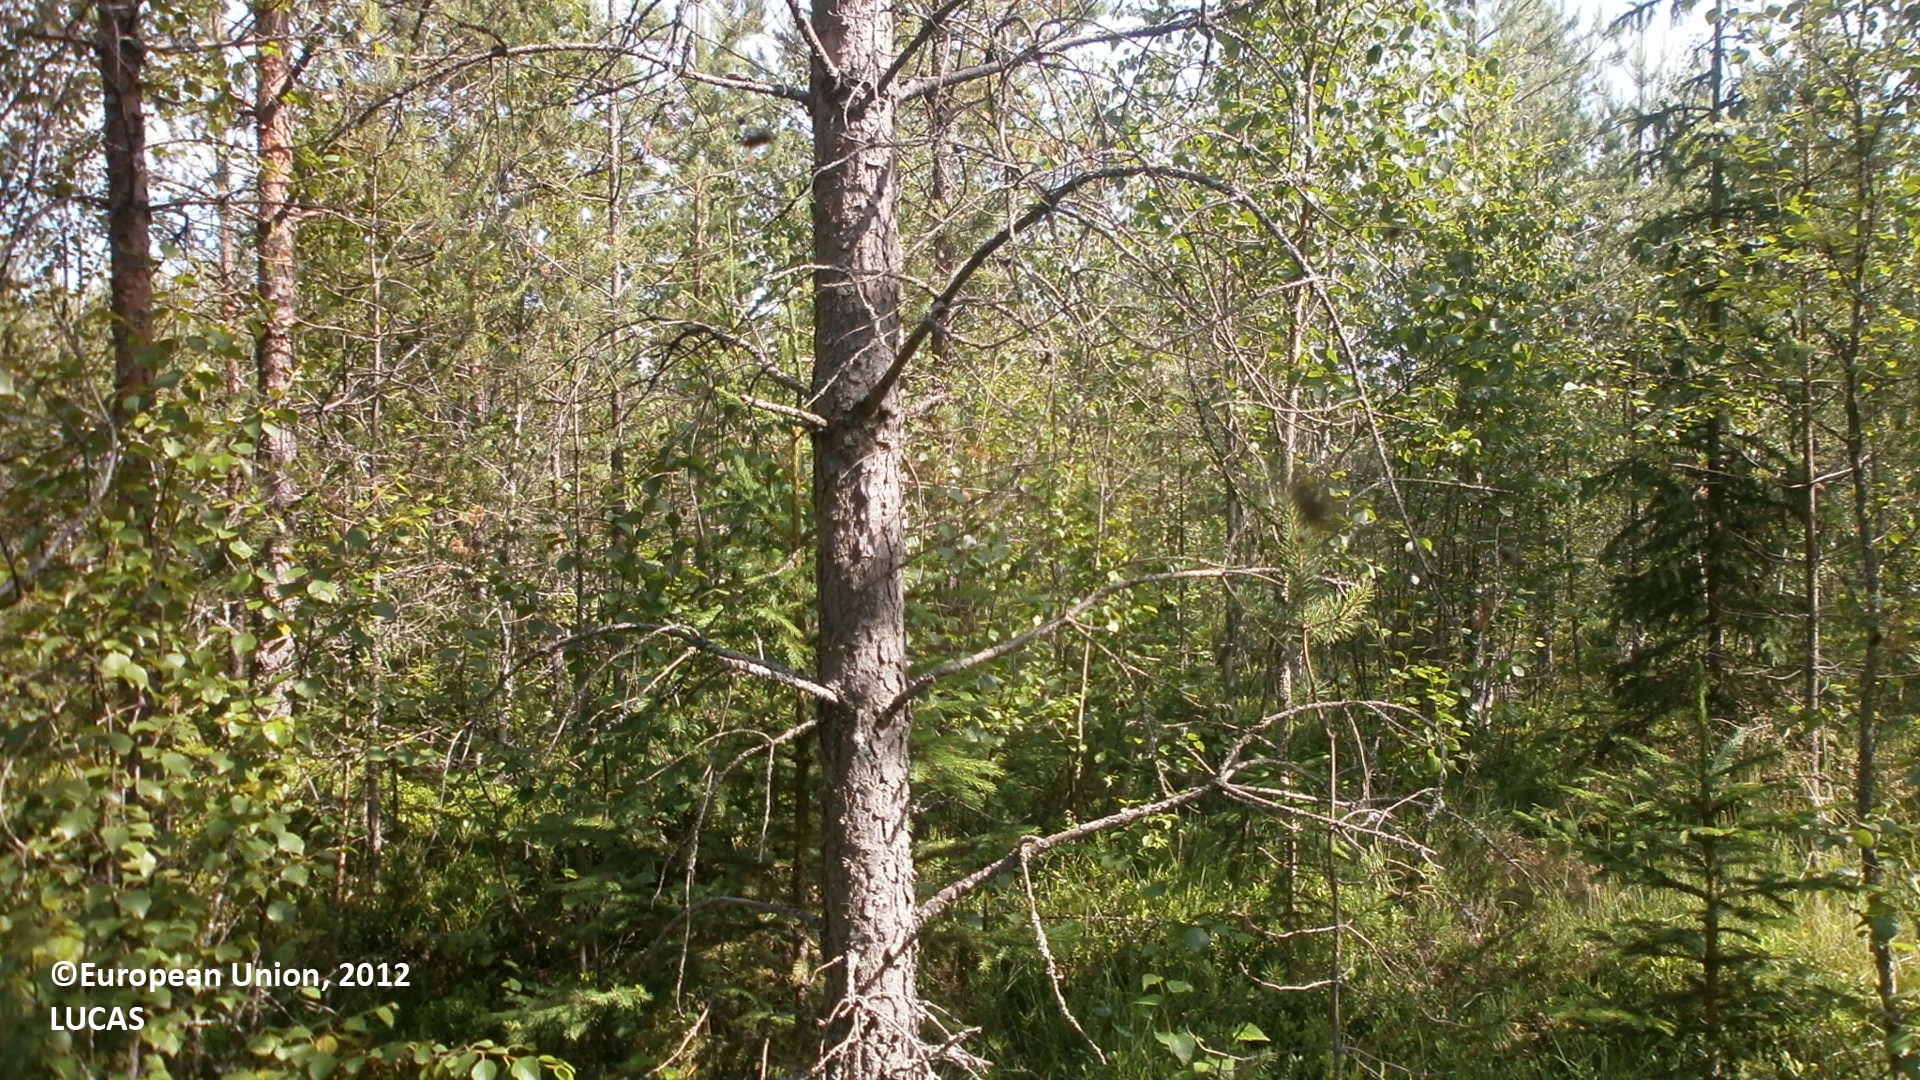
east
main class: Woodland
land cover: Pine dominated mixed woodland
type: boreal forest
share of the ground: 50 - 75 %
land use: Forestry
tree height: > 5 m
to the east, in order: Pine dominated mixed woodland; Lichens and moss; Pine dominated mixed woodland; Ditches and canals; Broadleaved woodland; Tracks; Broadleaved woodland; Ditches and canals; Broadleaved woodland; Ditches and canals; Broadleaved woodland; Ditches and canals; Broadleaved woodland; Ditches and canals; Broadleaved woodland
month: July
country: FI
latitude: 64.2489
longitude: 24.2395
